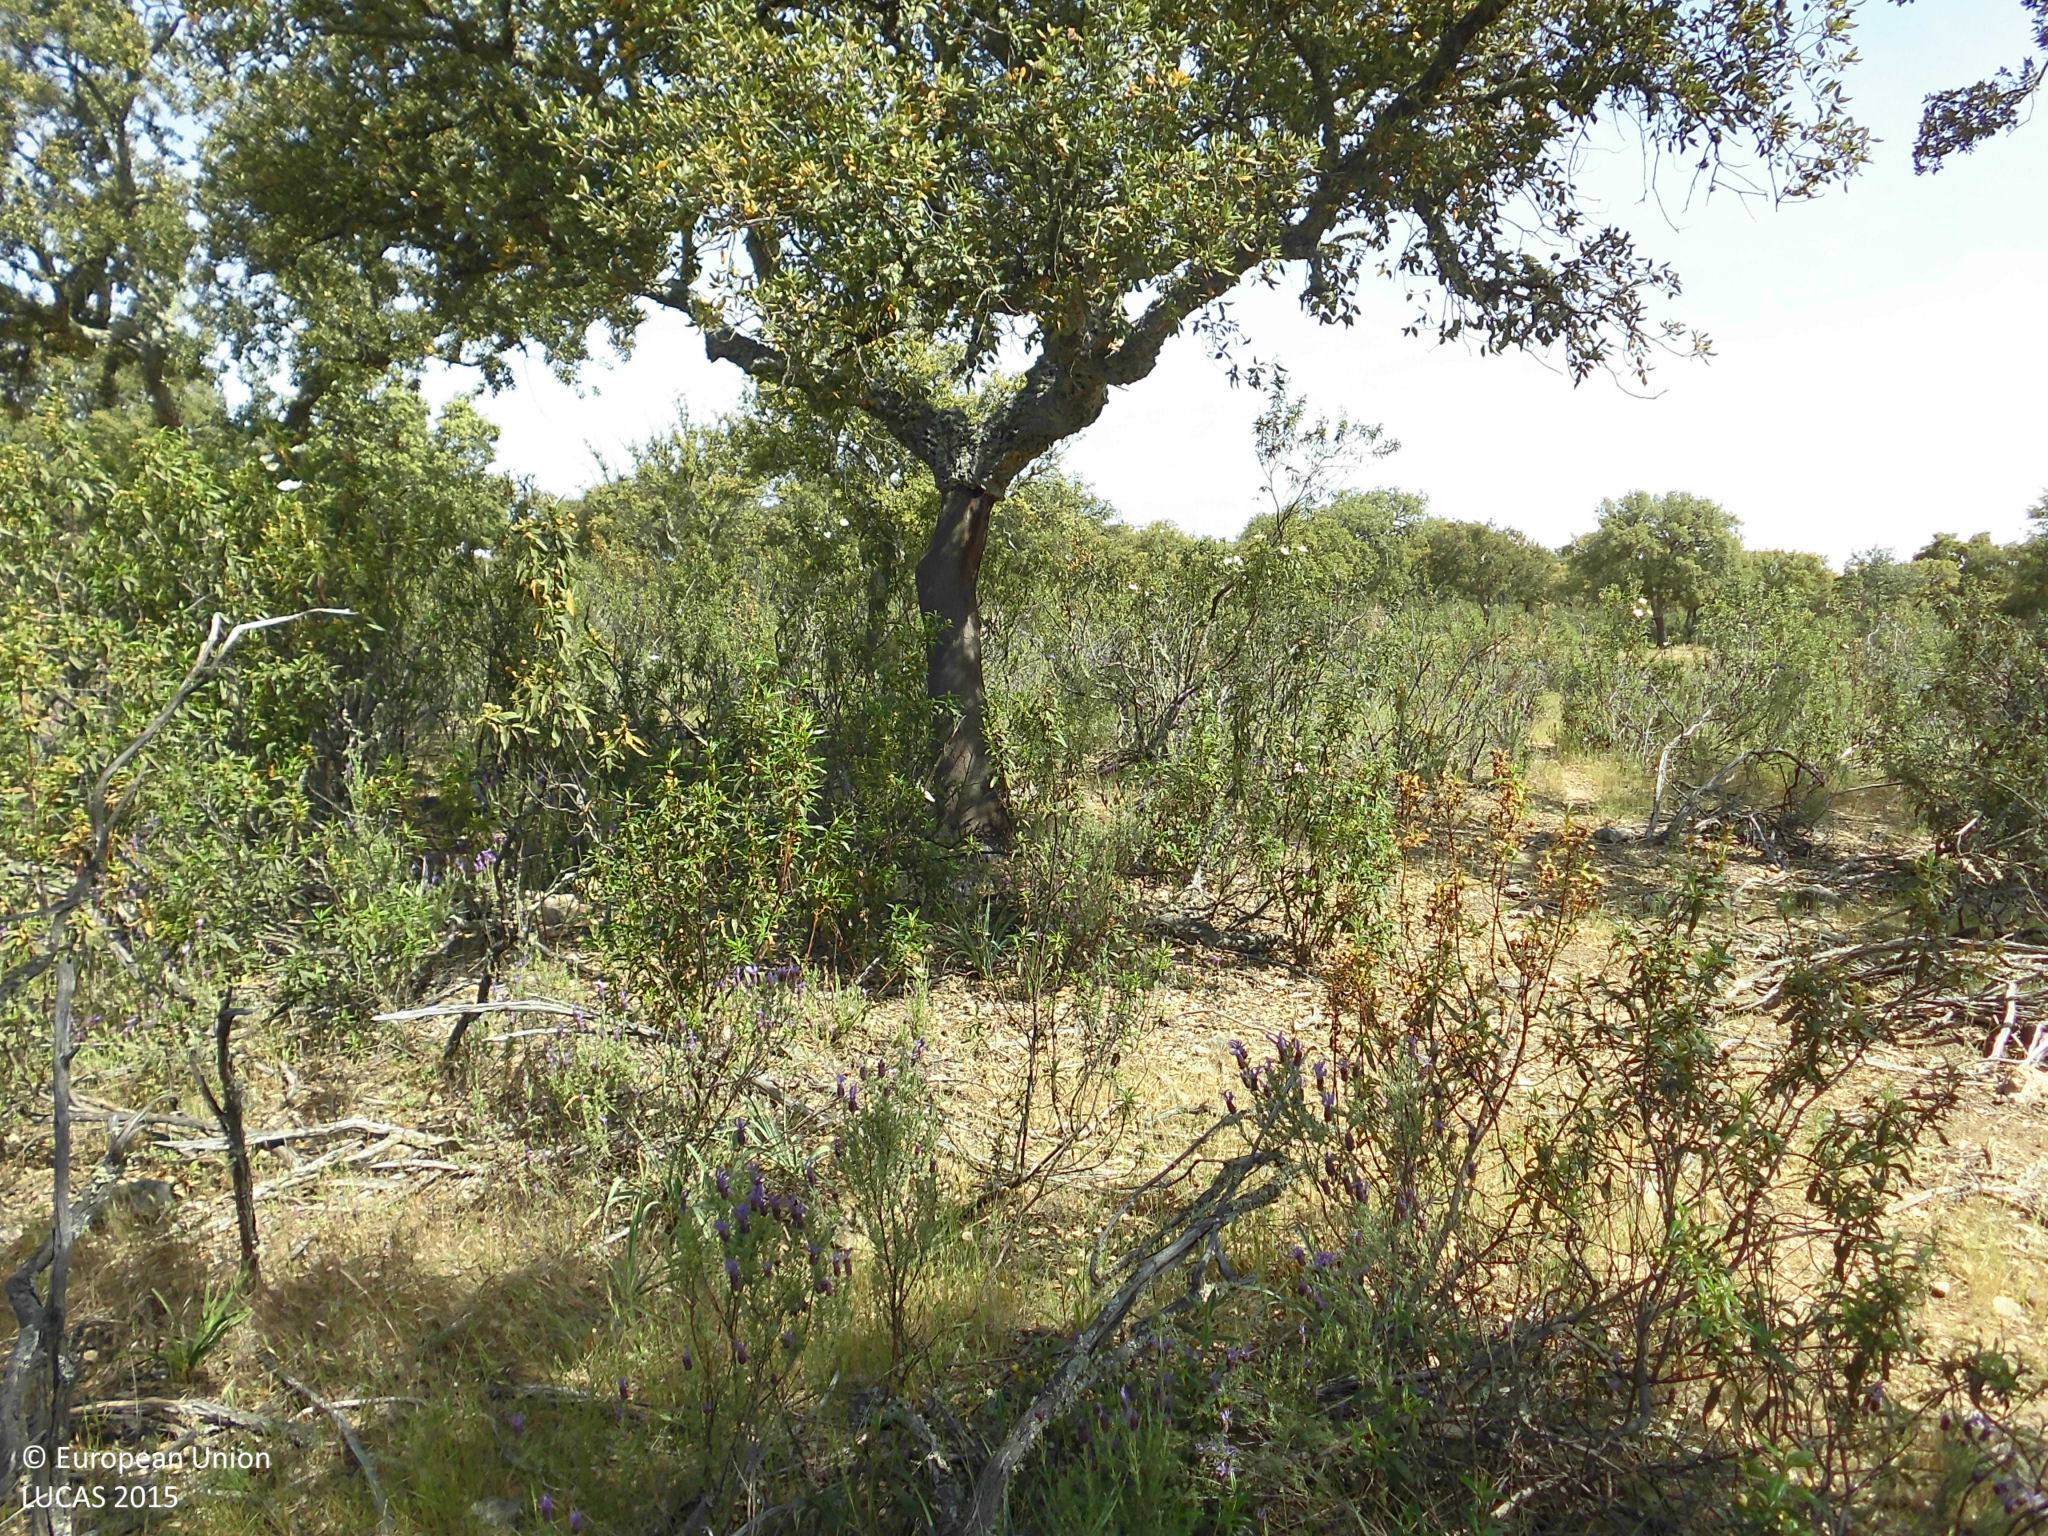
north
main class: Woodland
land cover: Broadleaved woodland
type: broadleaved evergreen forest
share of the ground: 10 - 25 %
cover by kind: herbaceous plants 55 %, shrubs 30 %, broadleaved forest trees 15 %
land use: Forestry
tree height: > 5 m
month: May
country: ES
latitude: 39.4705
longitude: -7.1130
